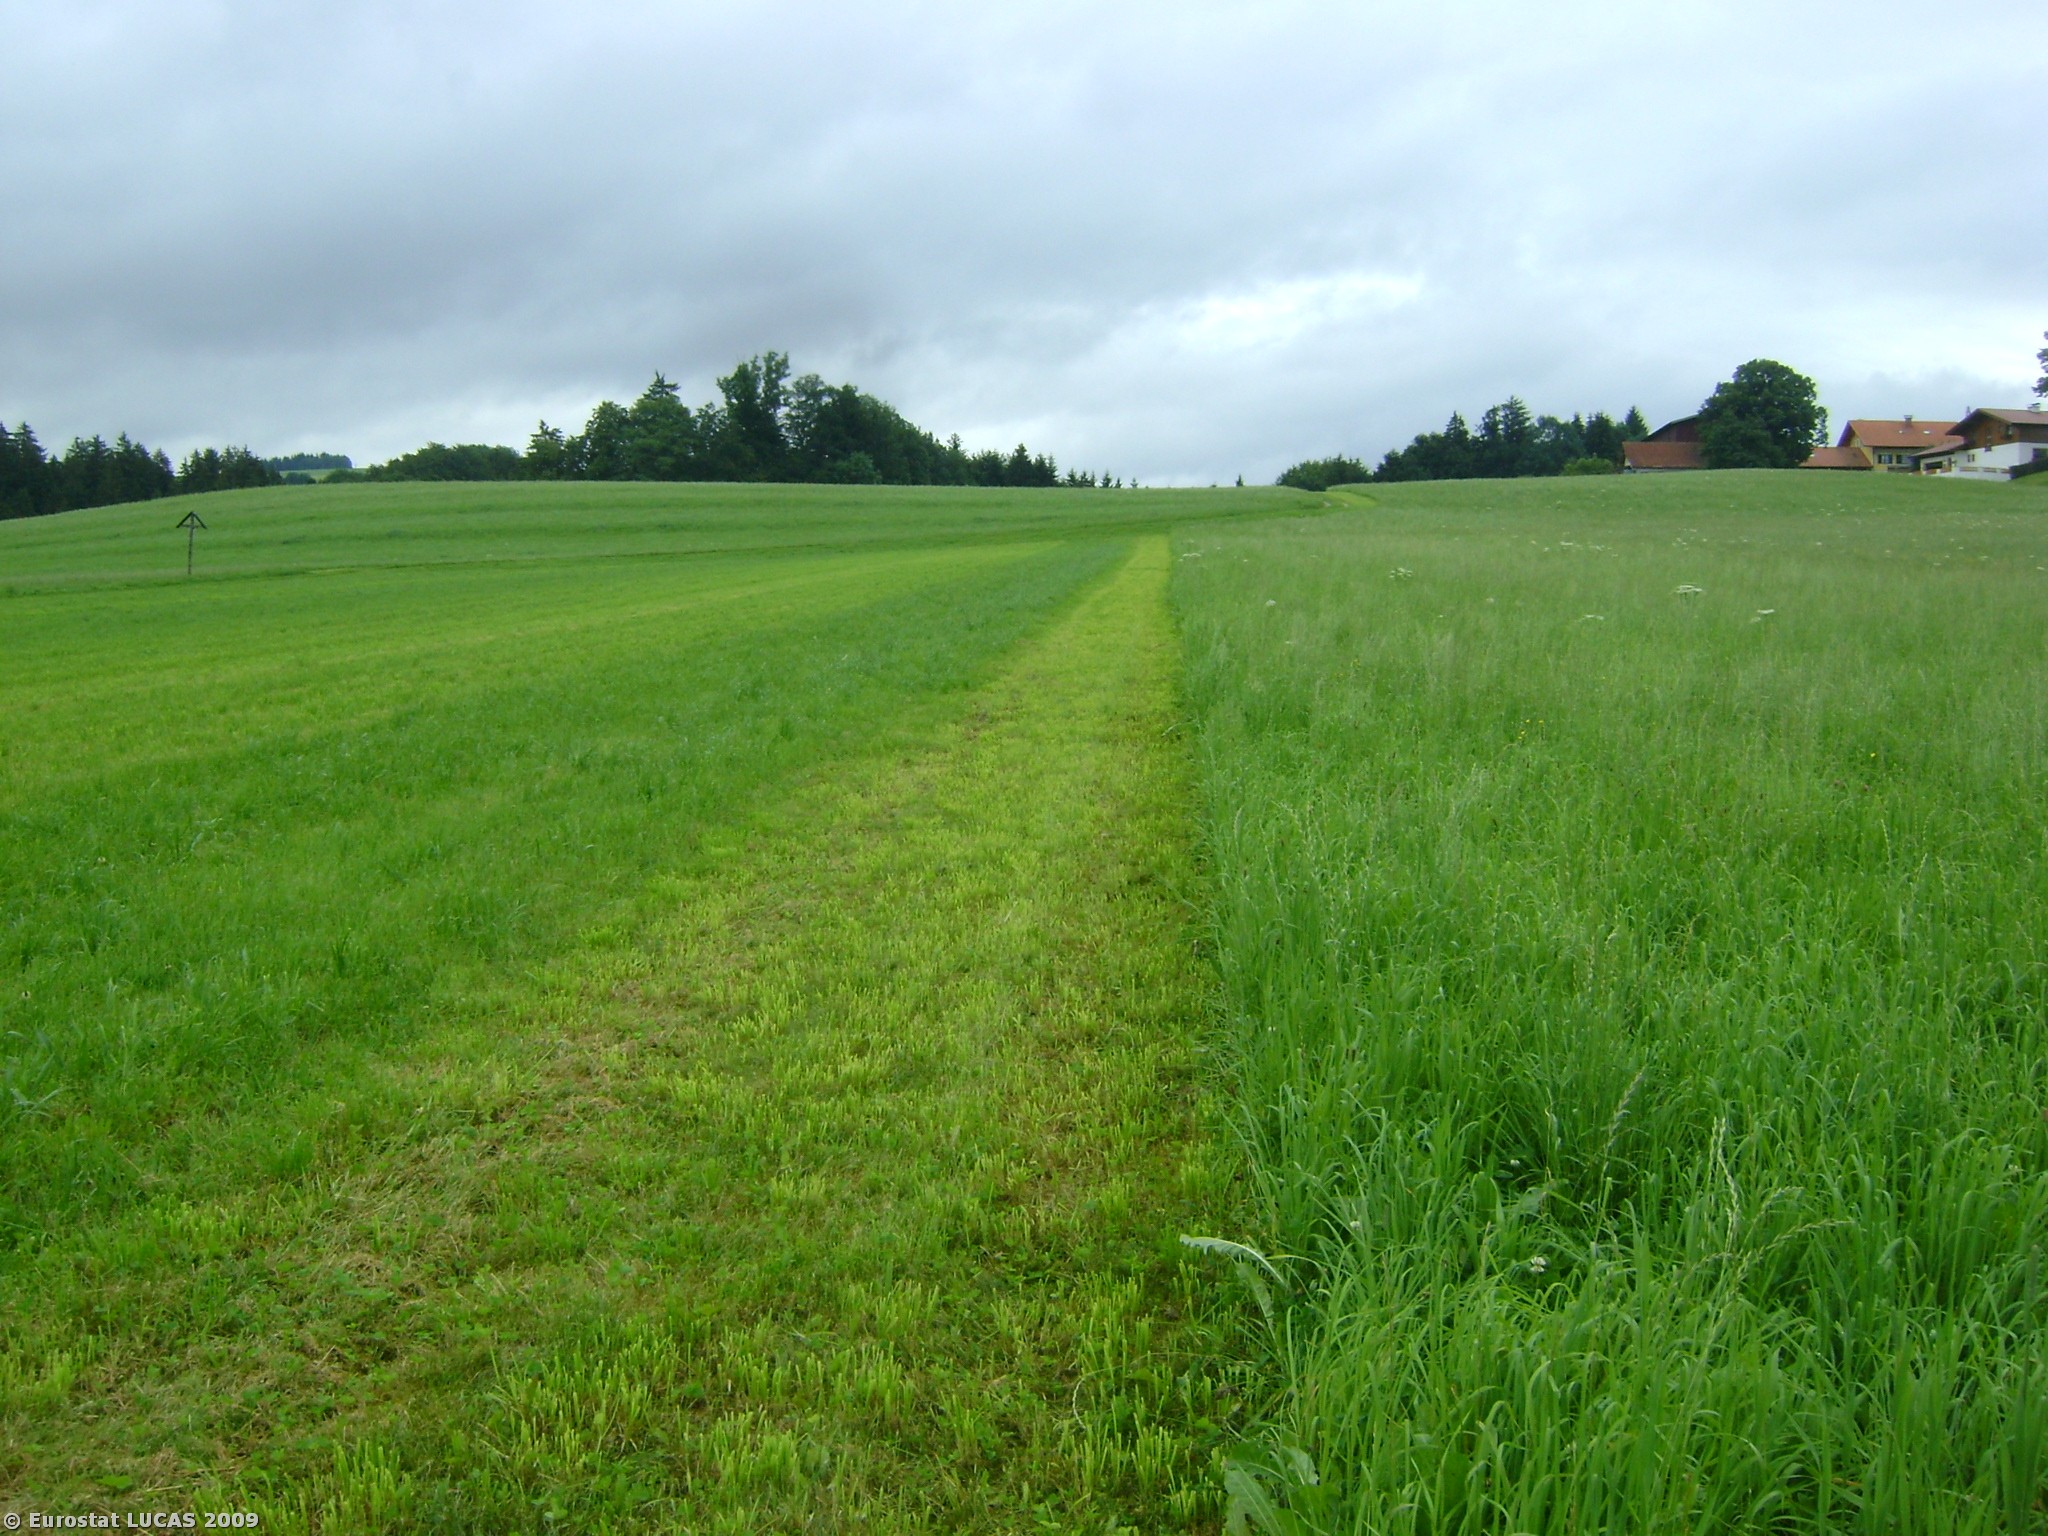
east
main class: Grassland
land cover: Grassland without tree/shrub cover
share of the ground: > 75 %
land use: Agriculture (excluding fallow land and kitchen gardens)
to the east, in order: Grassland without tree/shrub cover; Tracks; Grassland without tree/shrub cover
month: July
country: AT
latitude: 47.9415
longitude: 13.2520
